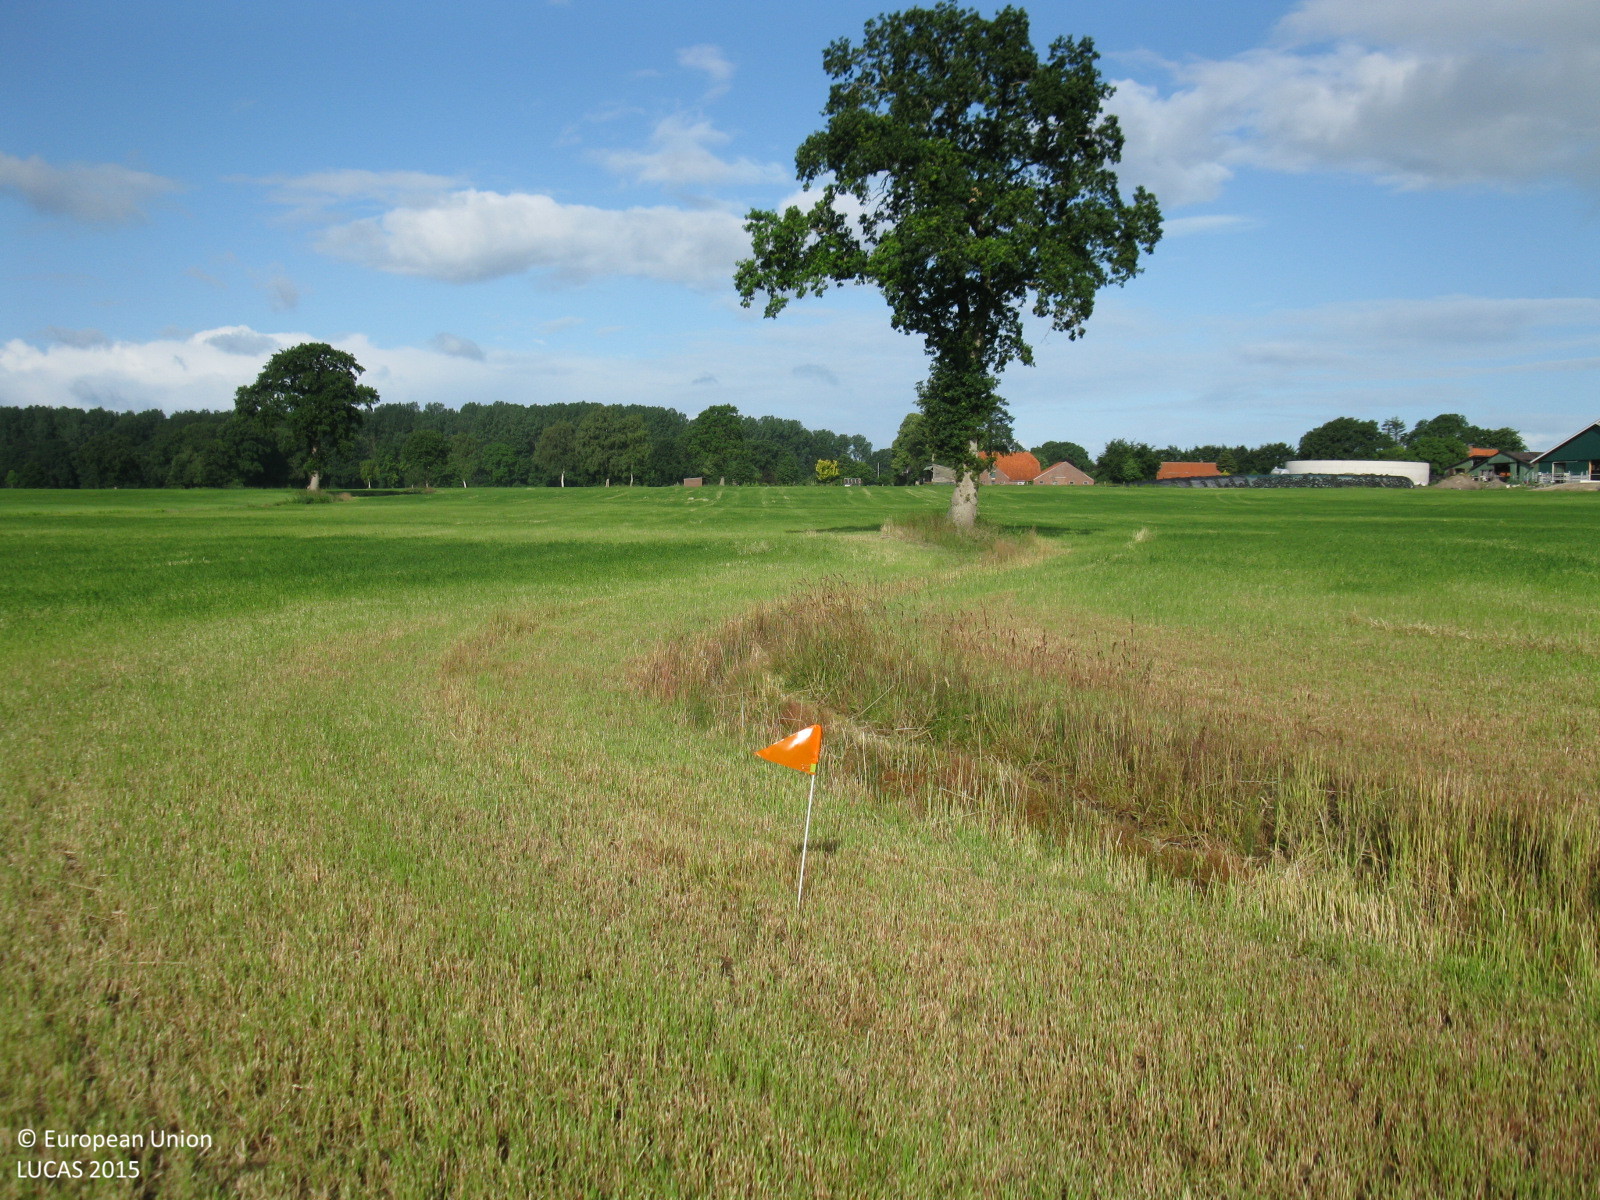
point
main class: Grassland
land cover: Grassland without tree/shrub cover
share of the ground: > 75 %
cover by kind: herbaceous plants 100 %
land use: Agriculture (excluding fallow land and kitchen gardens)
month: July
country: DE
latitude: 53.4029
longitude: 7.9701
